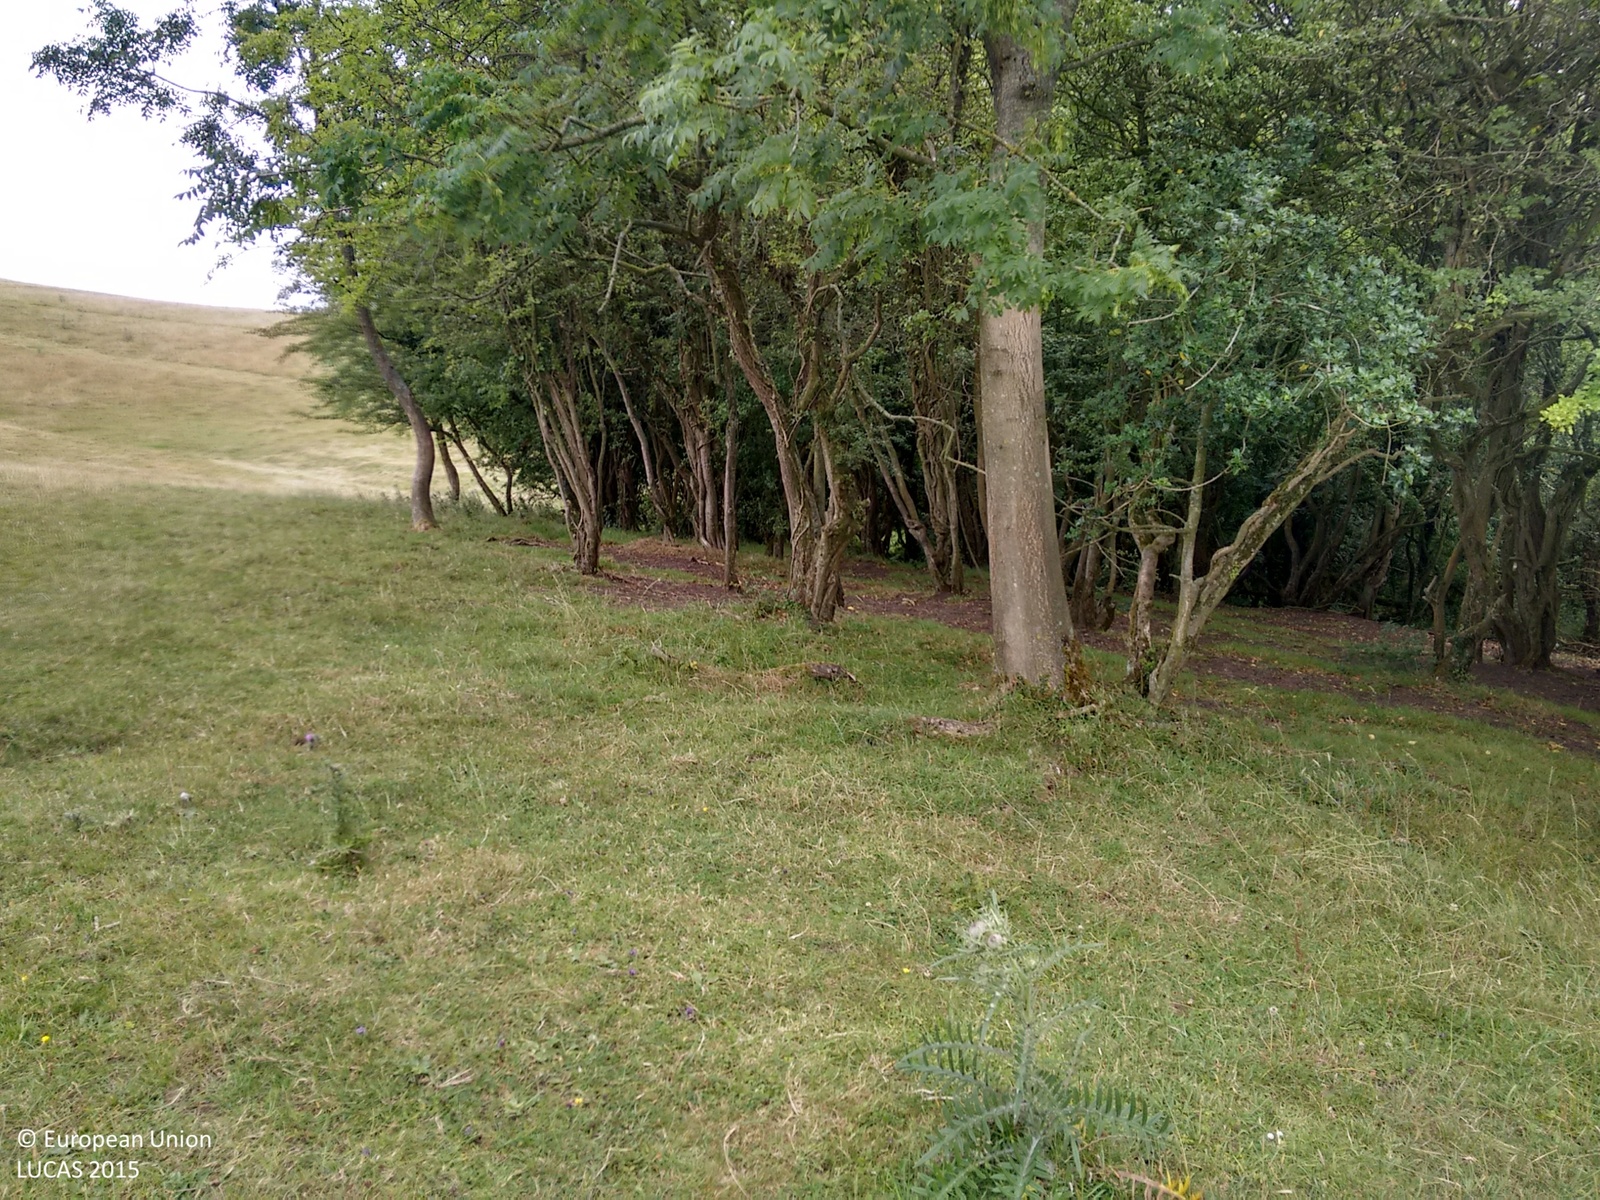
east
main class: Grassland
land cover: Grassland without tree/shrub cover
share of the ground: > 75 %
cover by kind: herbaceous plants 100 %
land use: Agriculture (excluding fallow land and kitchen gardens)
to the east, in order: Grassland without tree/shrub cover; Broadleaved woodland; Grassland without tree/shrub cover
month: July
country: GB
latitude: 51.4576
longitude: -2.3403
